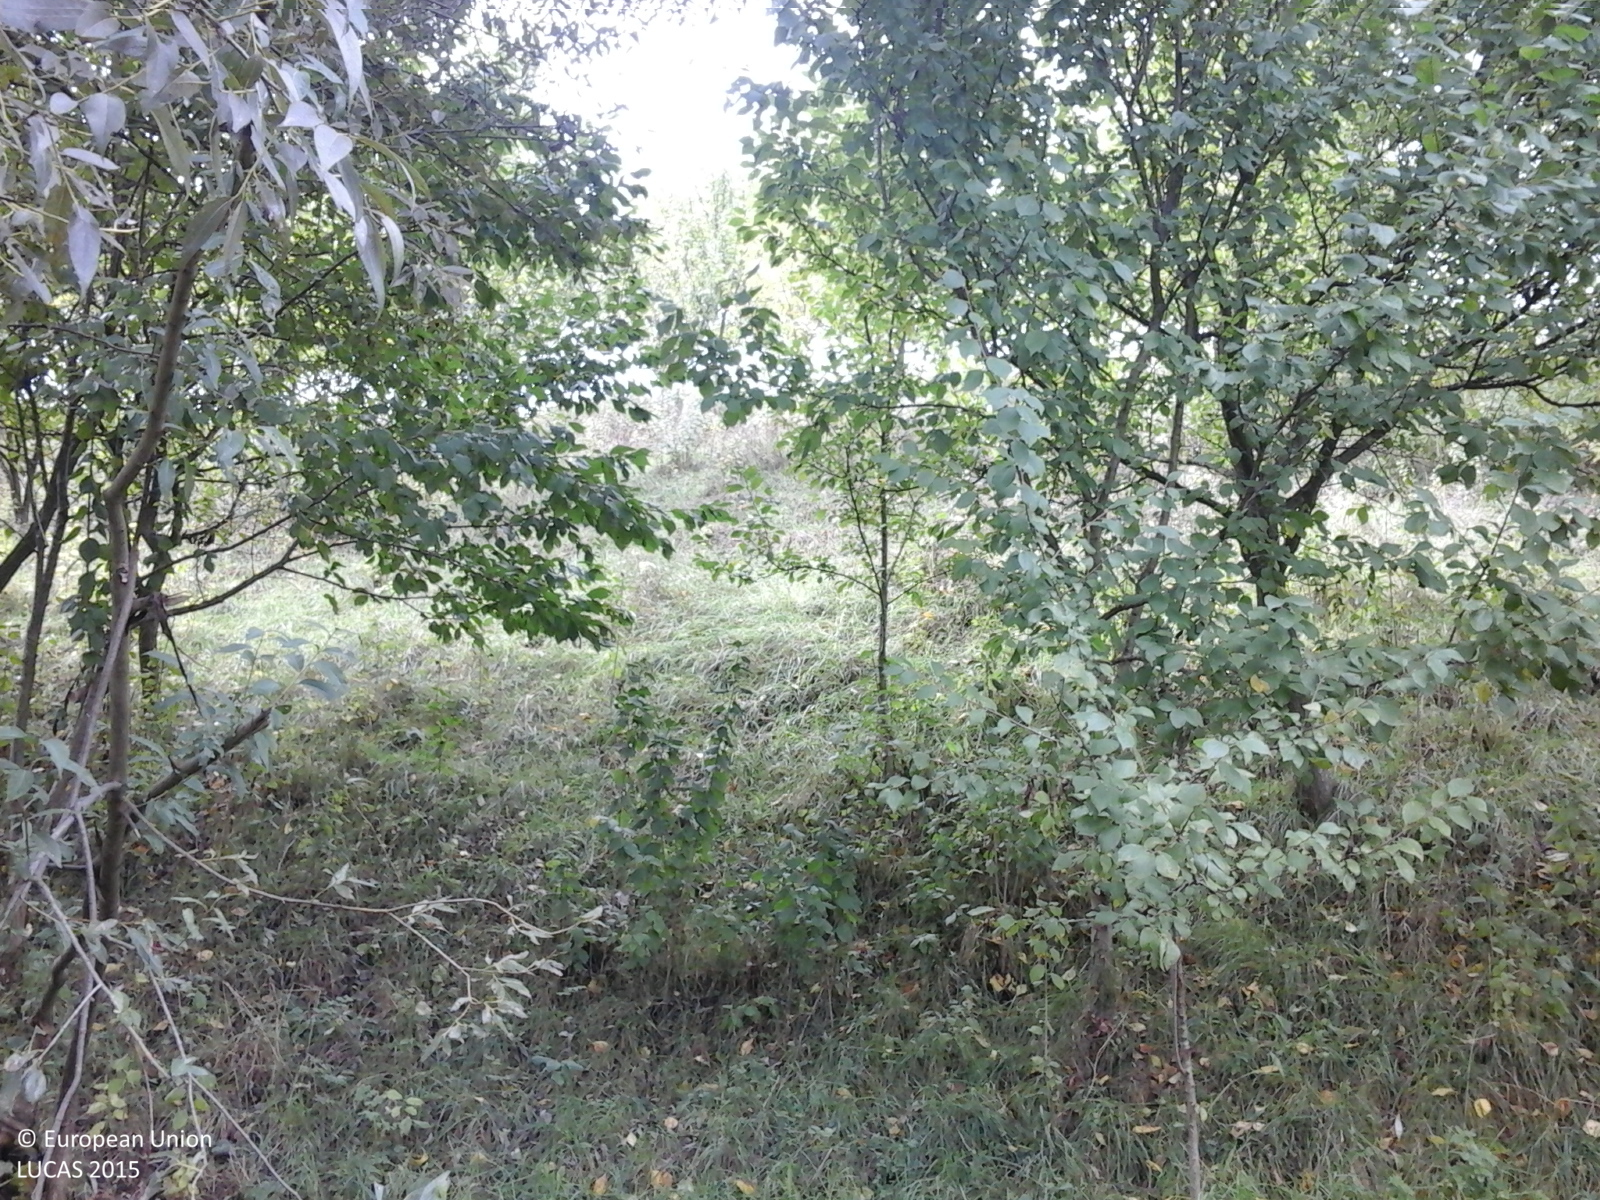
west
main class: Grassland
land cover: Grassland with sparse tree/shrub cover
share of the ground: > 75 %
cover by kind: herbaceous plants 85 %, shrubs 10 %, broadleaved forest trees 5 %
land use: Agriculture (excluding fallow land and kitchen gardens)
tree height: < 5 m
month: September
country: RO
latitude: 46.0276
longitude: 23.7238
